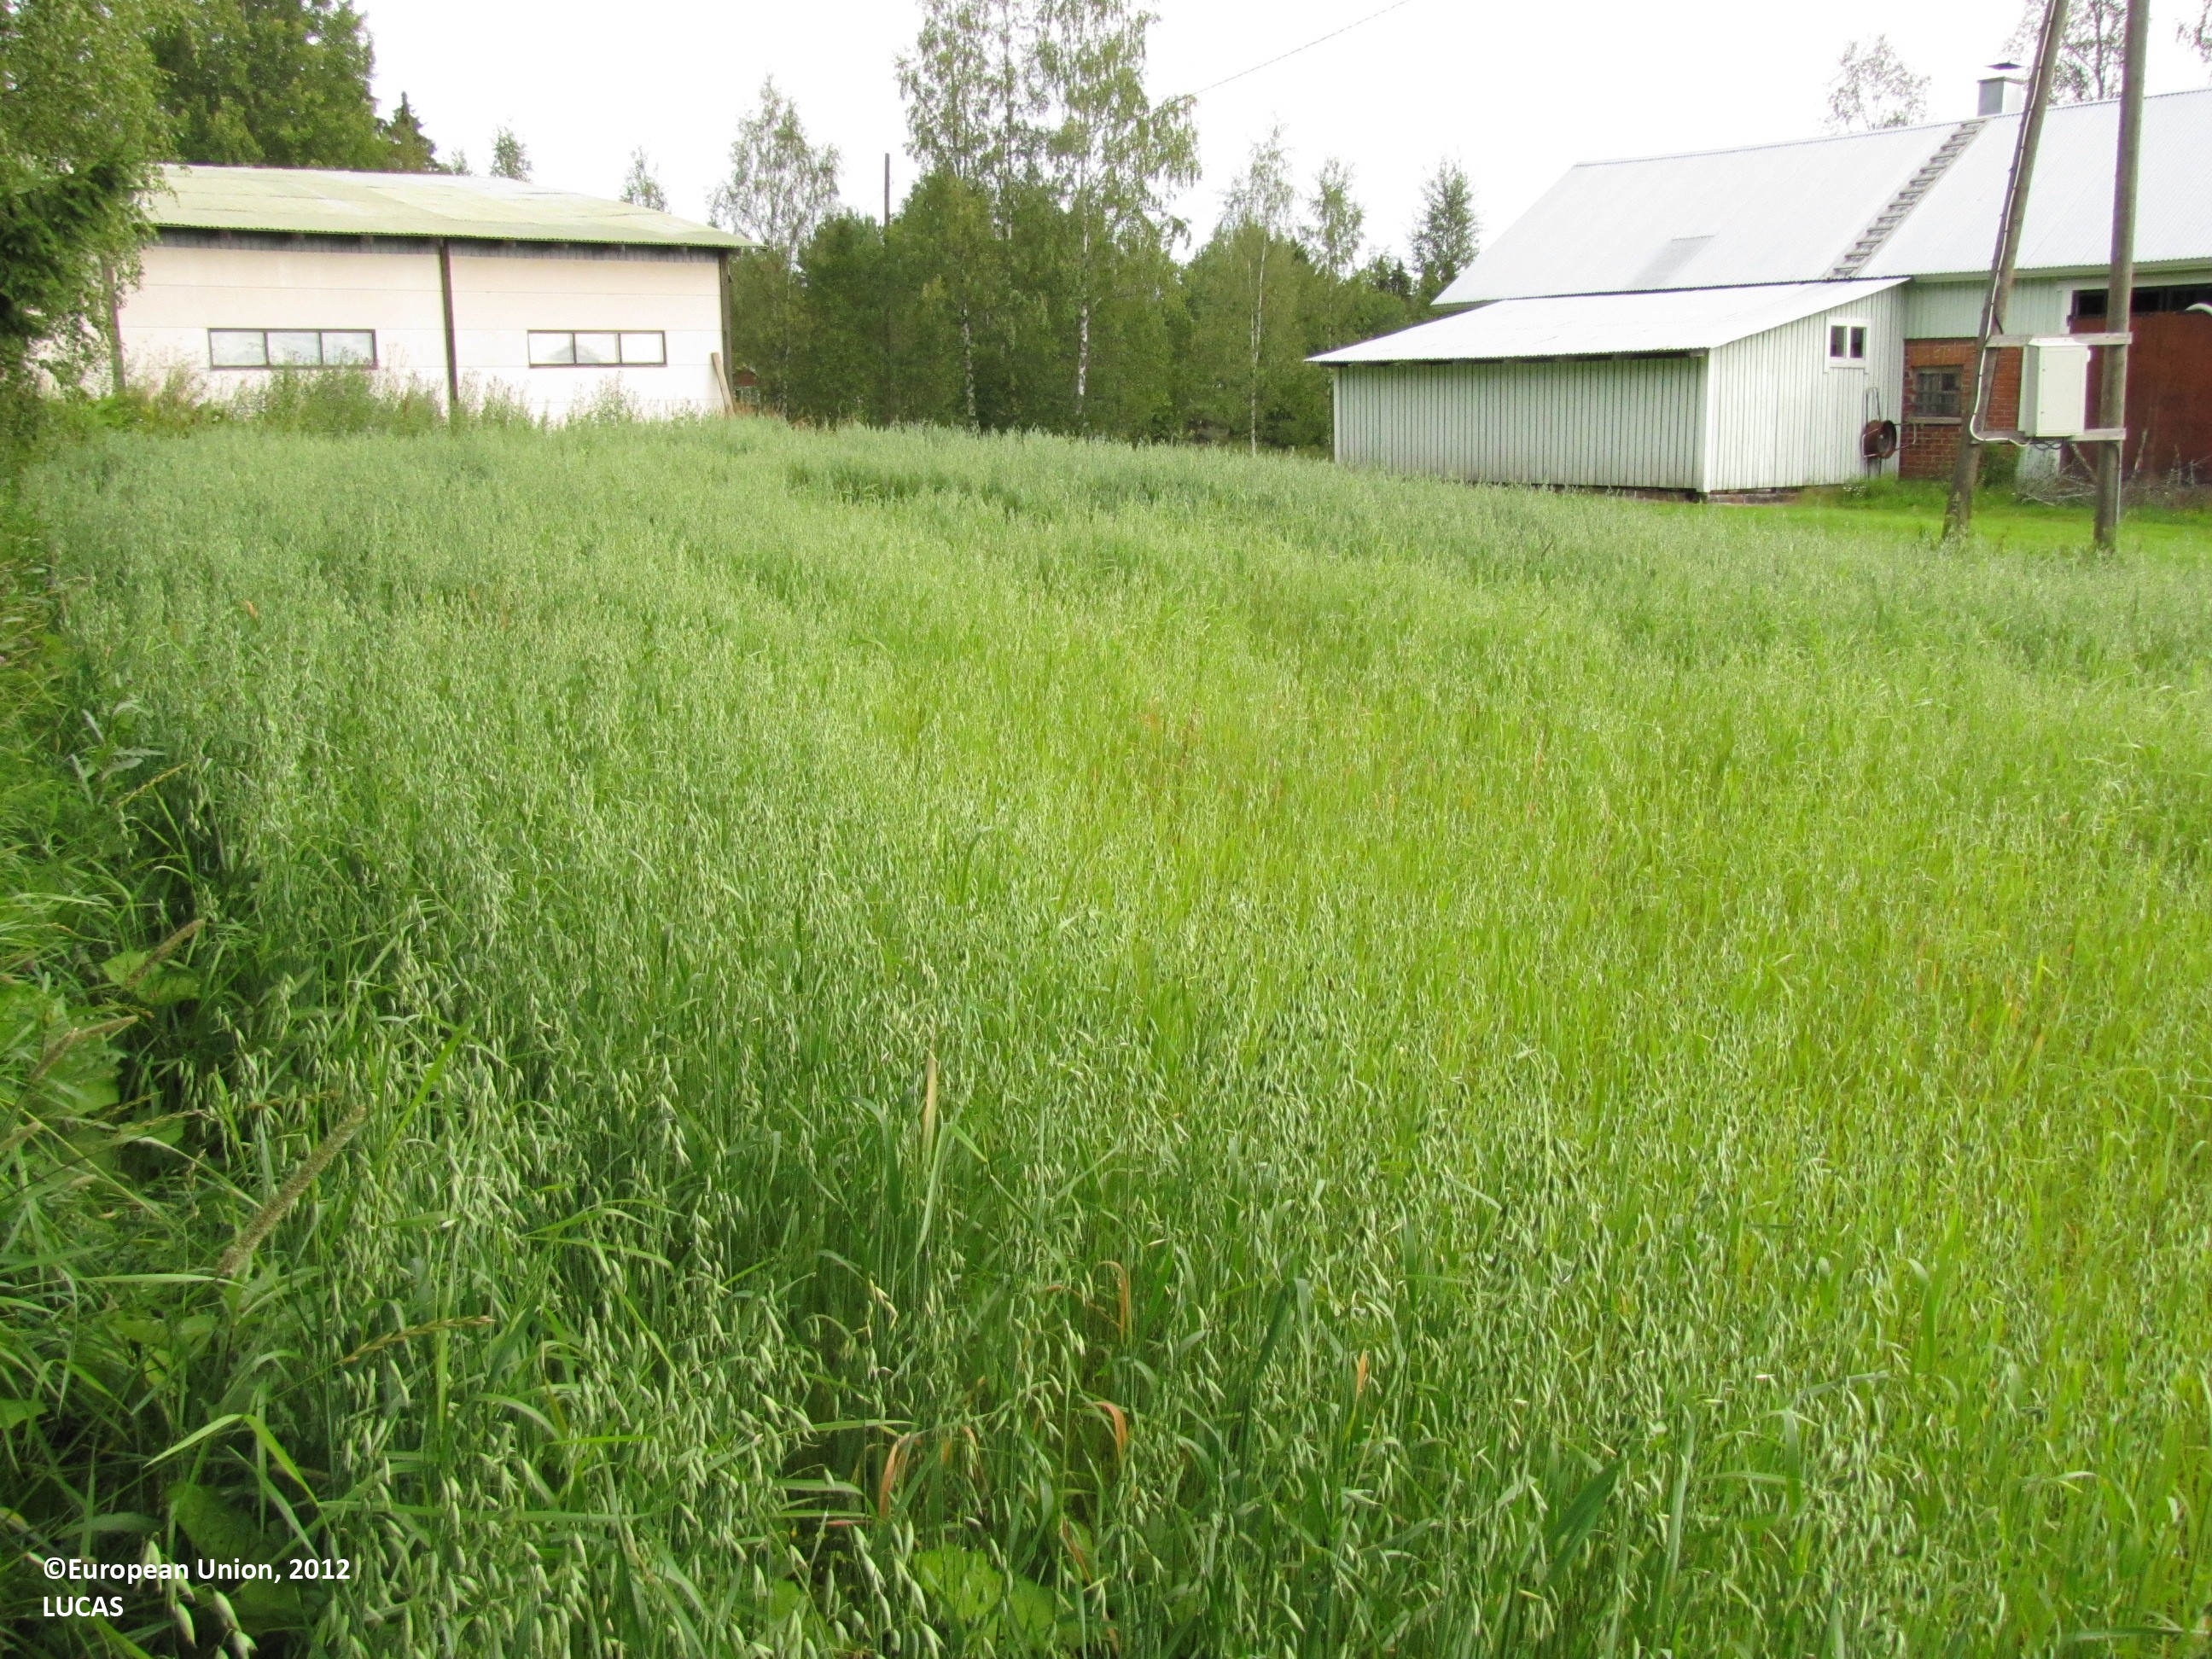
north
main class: Cropland
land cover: Oats
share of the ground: > 75 %
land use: Agriculture (excluding fallow land and kitchen gardens)
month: August
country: FI
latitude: 61.8119
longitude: 22.9532
